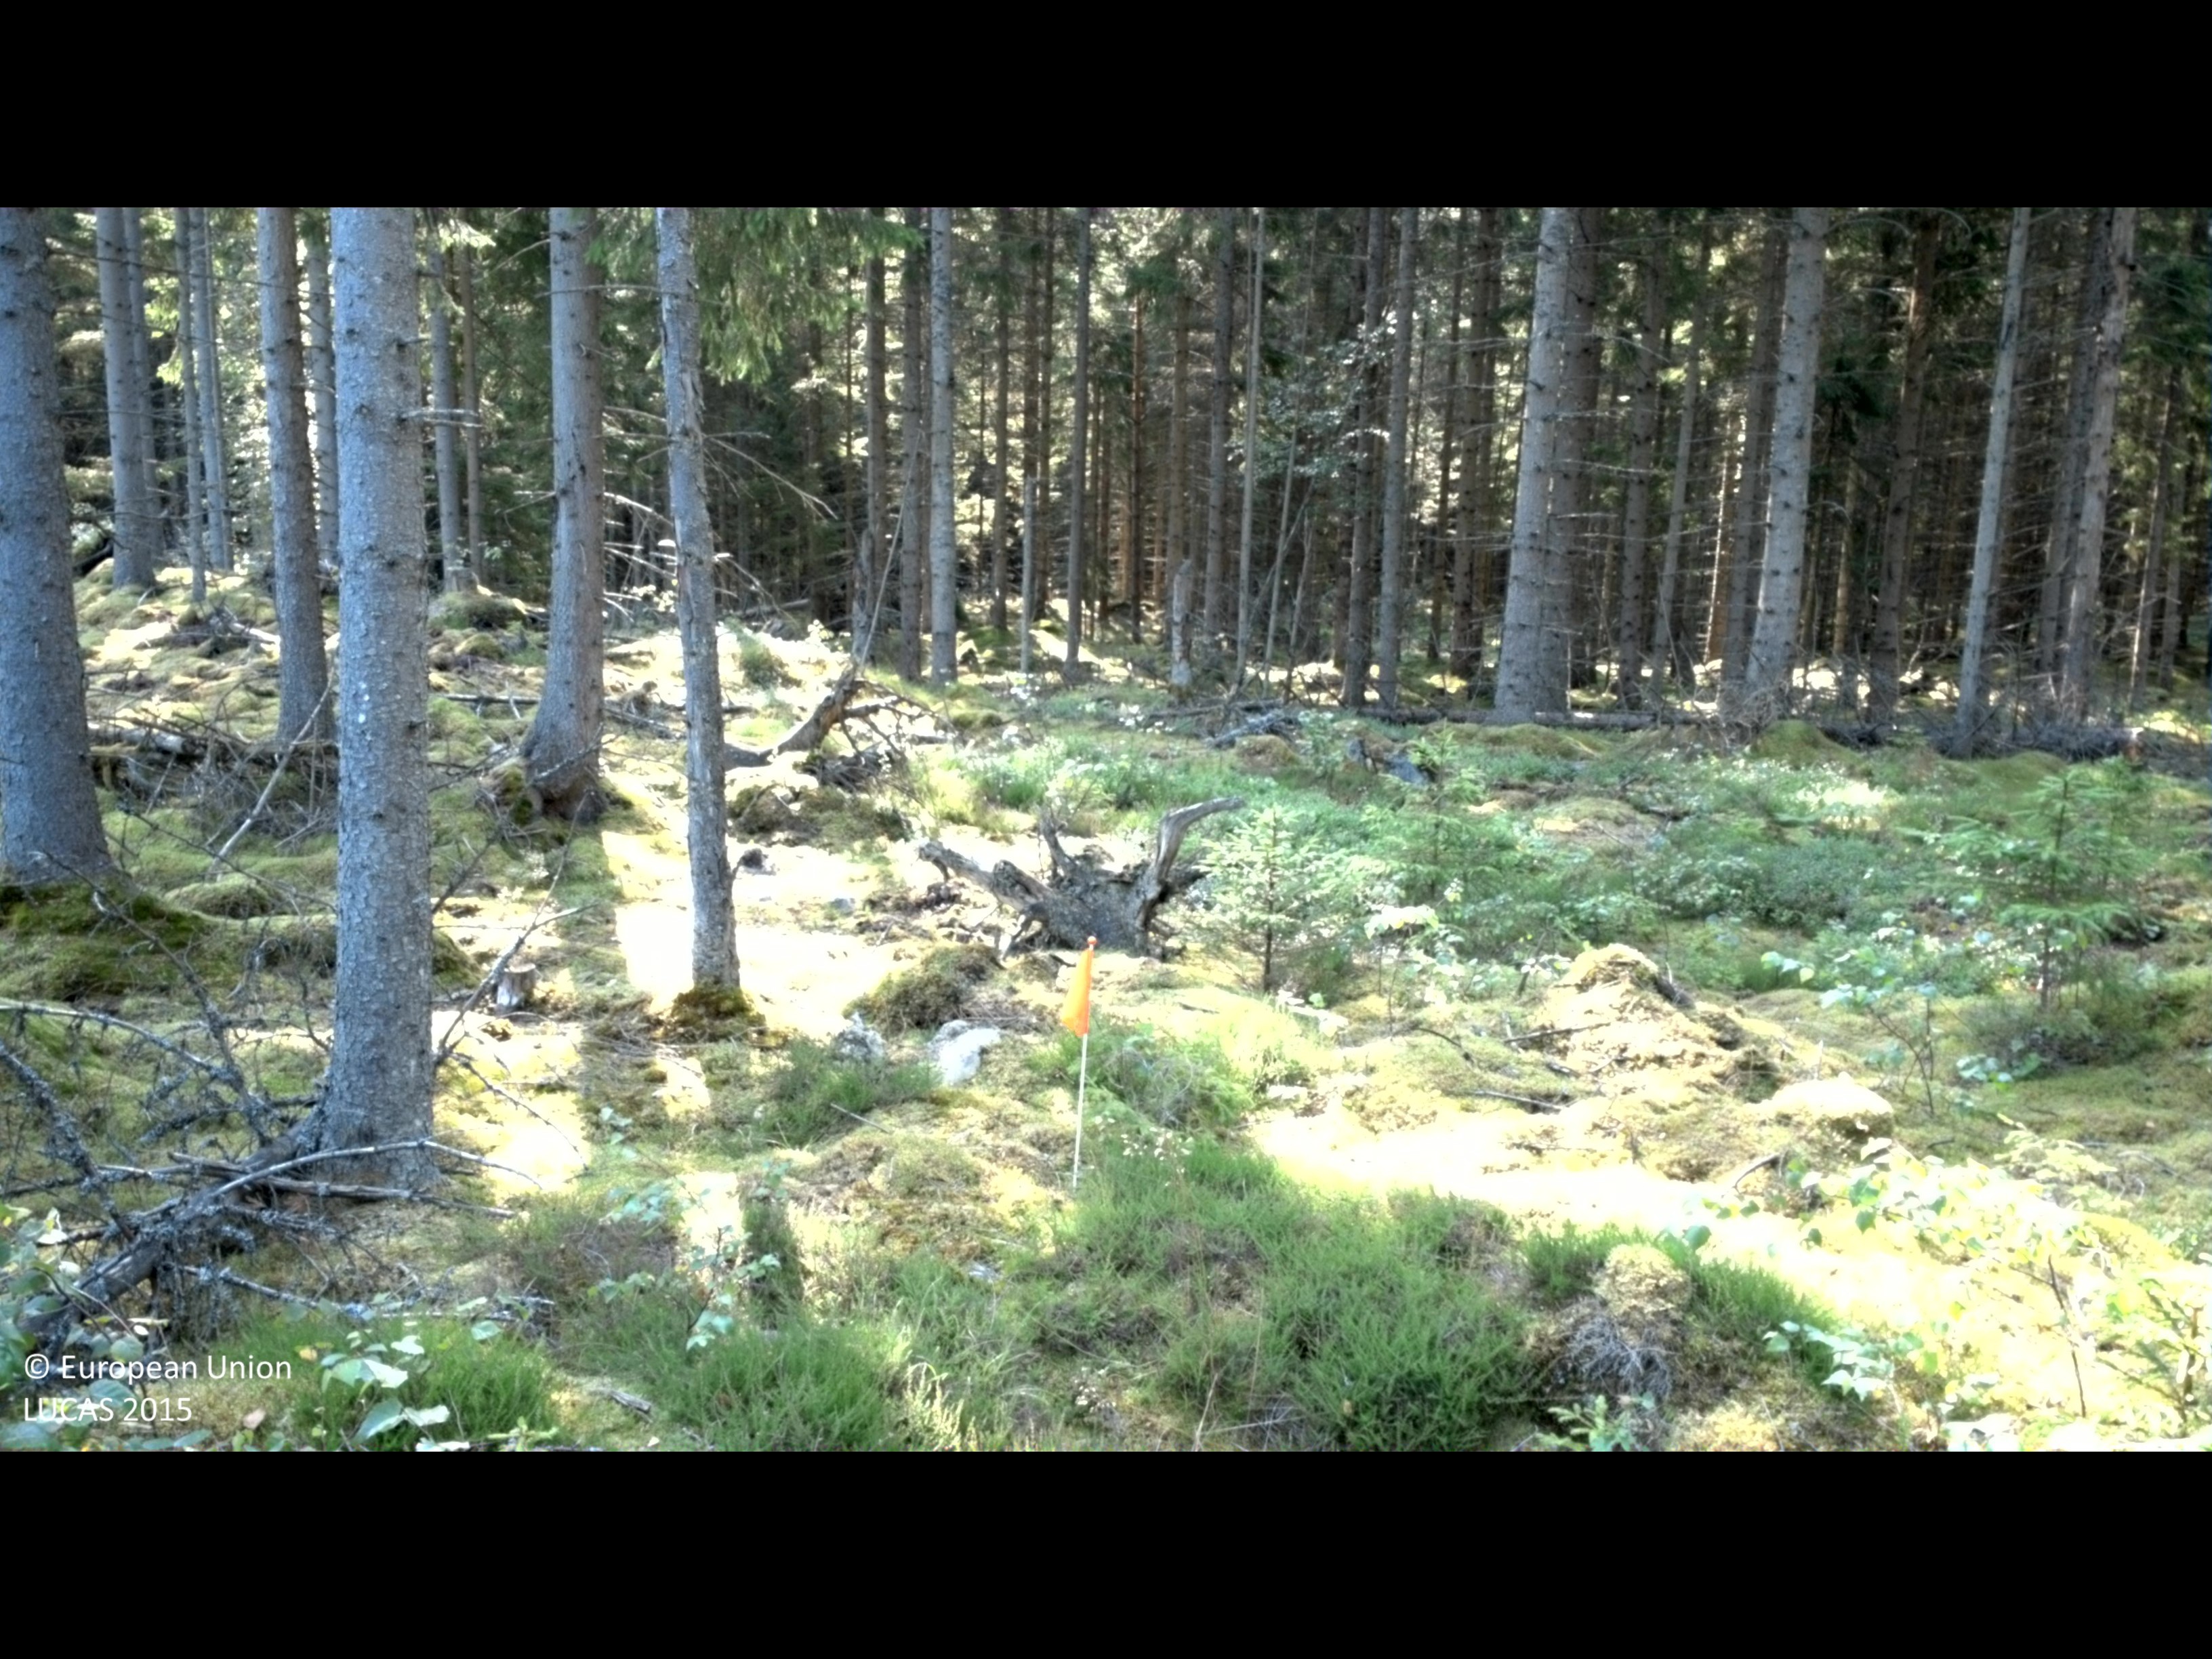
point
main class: Woodland
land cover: Spruce dominated coniferous woodland
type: boreal forest
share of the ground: 50 - 75 %
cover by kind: coniferous forest trees 70 %, lichens and mosses 20 %, shrubs 10 %
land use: Forestry
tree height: > 5 m
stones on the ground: 25 - 50 %
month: August
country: SE
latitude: 56.6457
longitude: 14.0576
